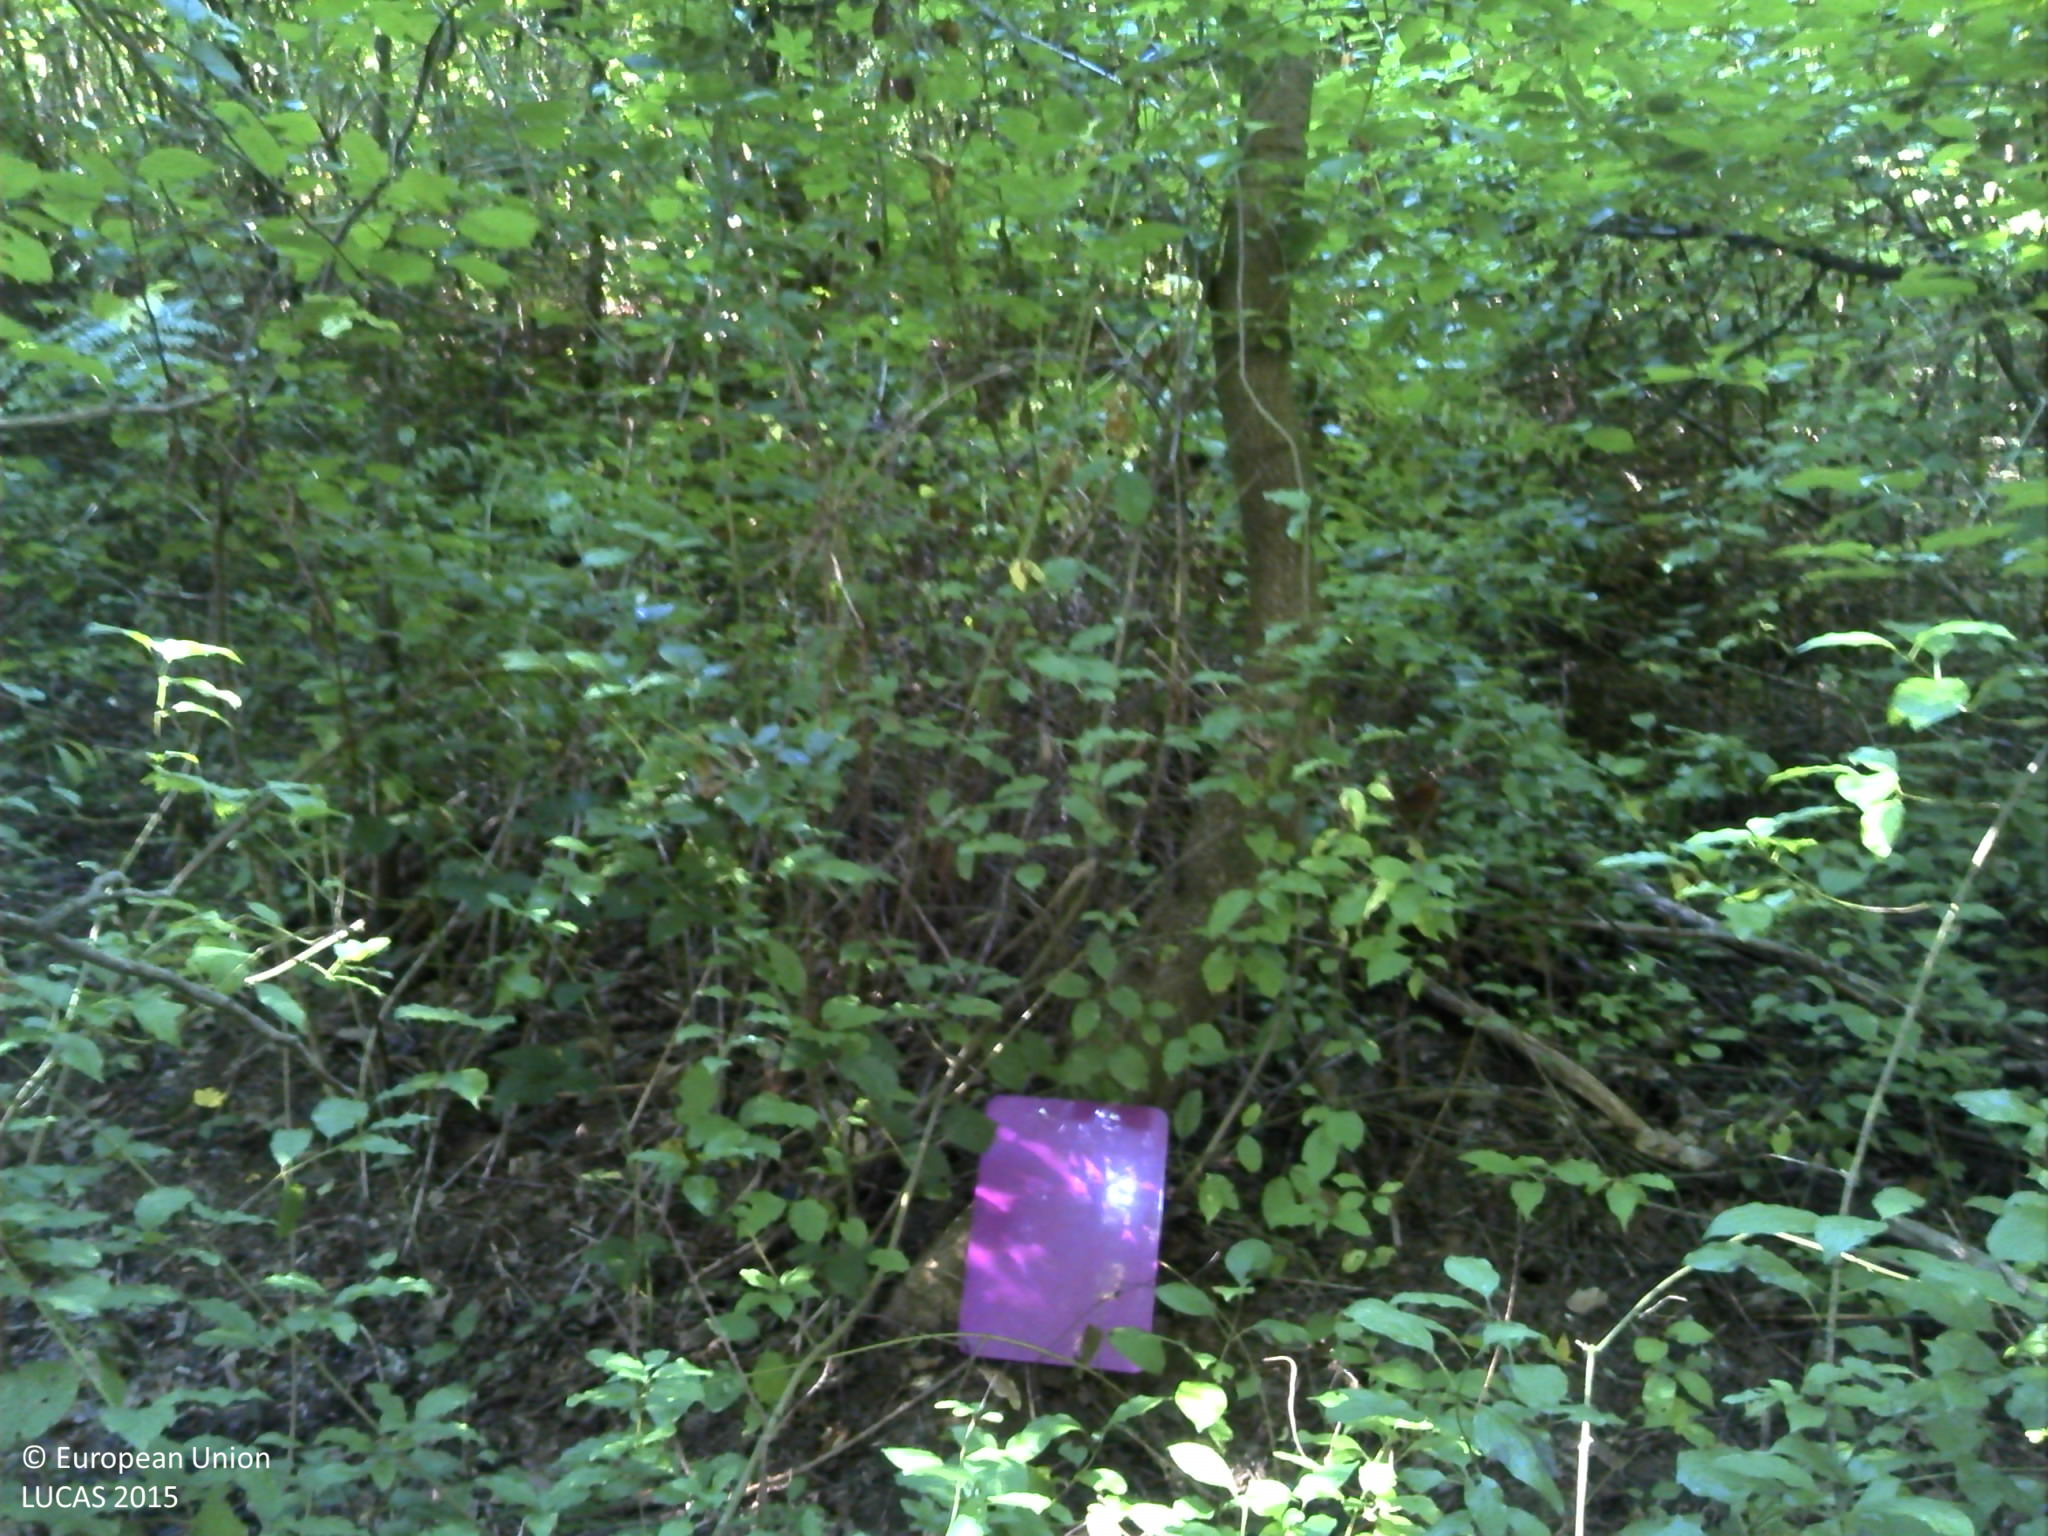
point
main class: Woodland
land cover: Broadleaved woodland
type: beech forest
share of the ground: > 75 %
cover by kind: broadleaved forest trees 100 %
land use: Forestry
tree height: > 5 m
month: August
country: HR
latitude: 45.0971
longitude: 16.3375
